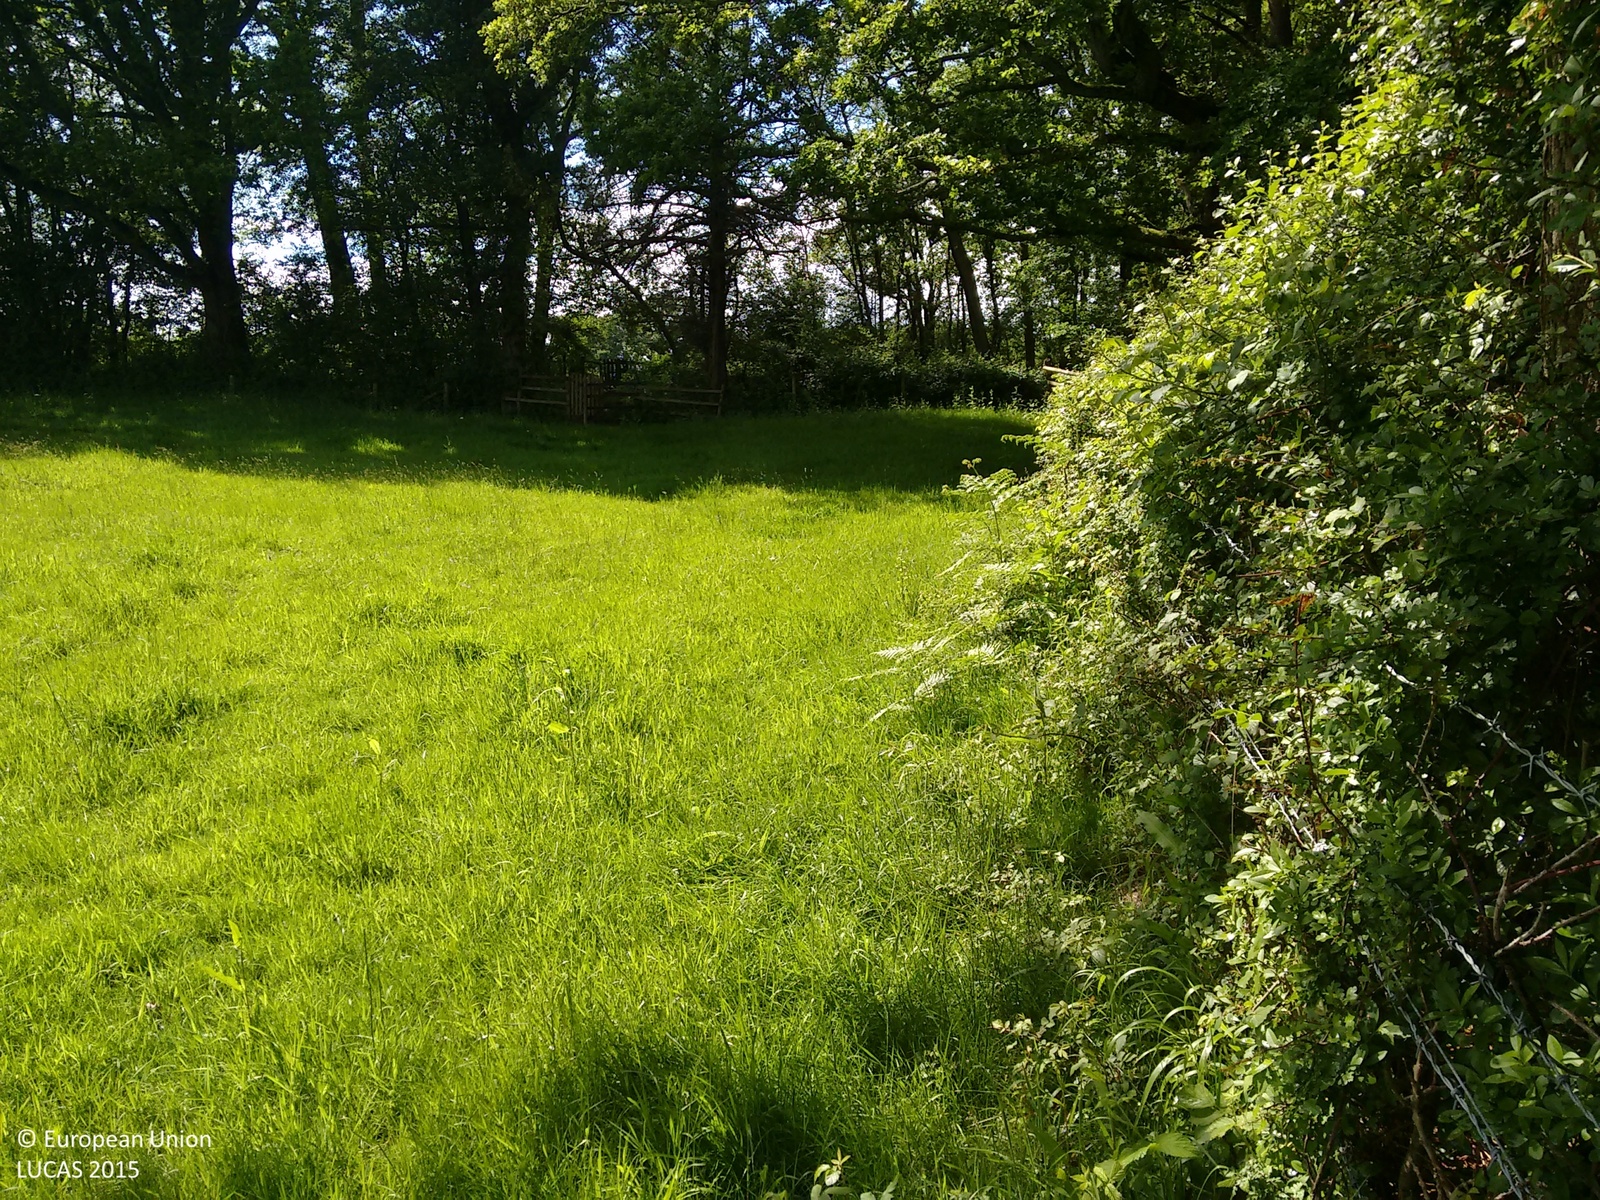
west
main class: Woodland
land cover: Broadleaved woodland
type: mesophytic deciduous forest
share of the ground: > 75 %
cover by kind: broadleaved forest trees 100 %
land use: Forestry
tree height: > 5 m
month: May
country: GB
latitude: 51.0108
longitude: -1.3806
